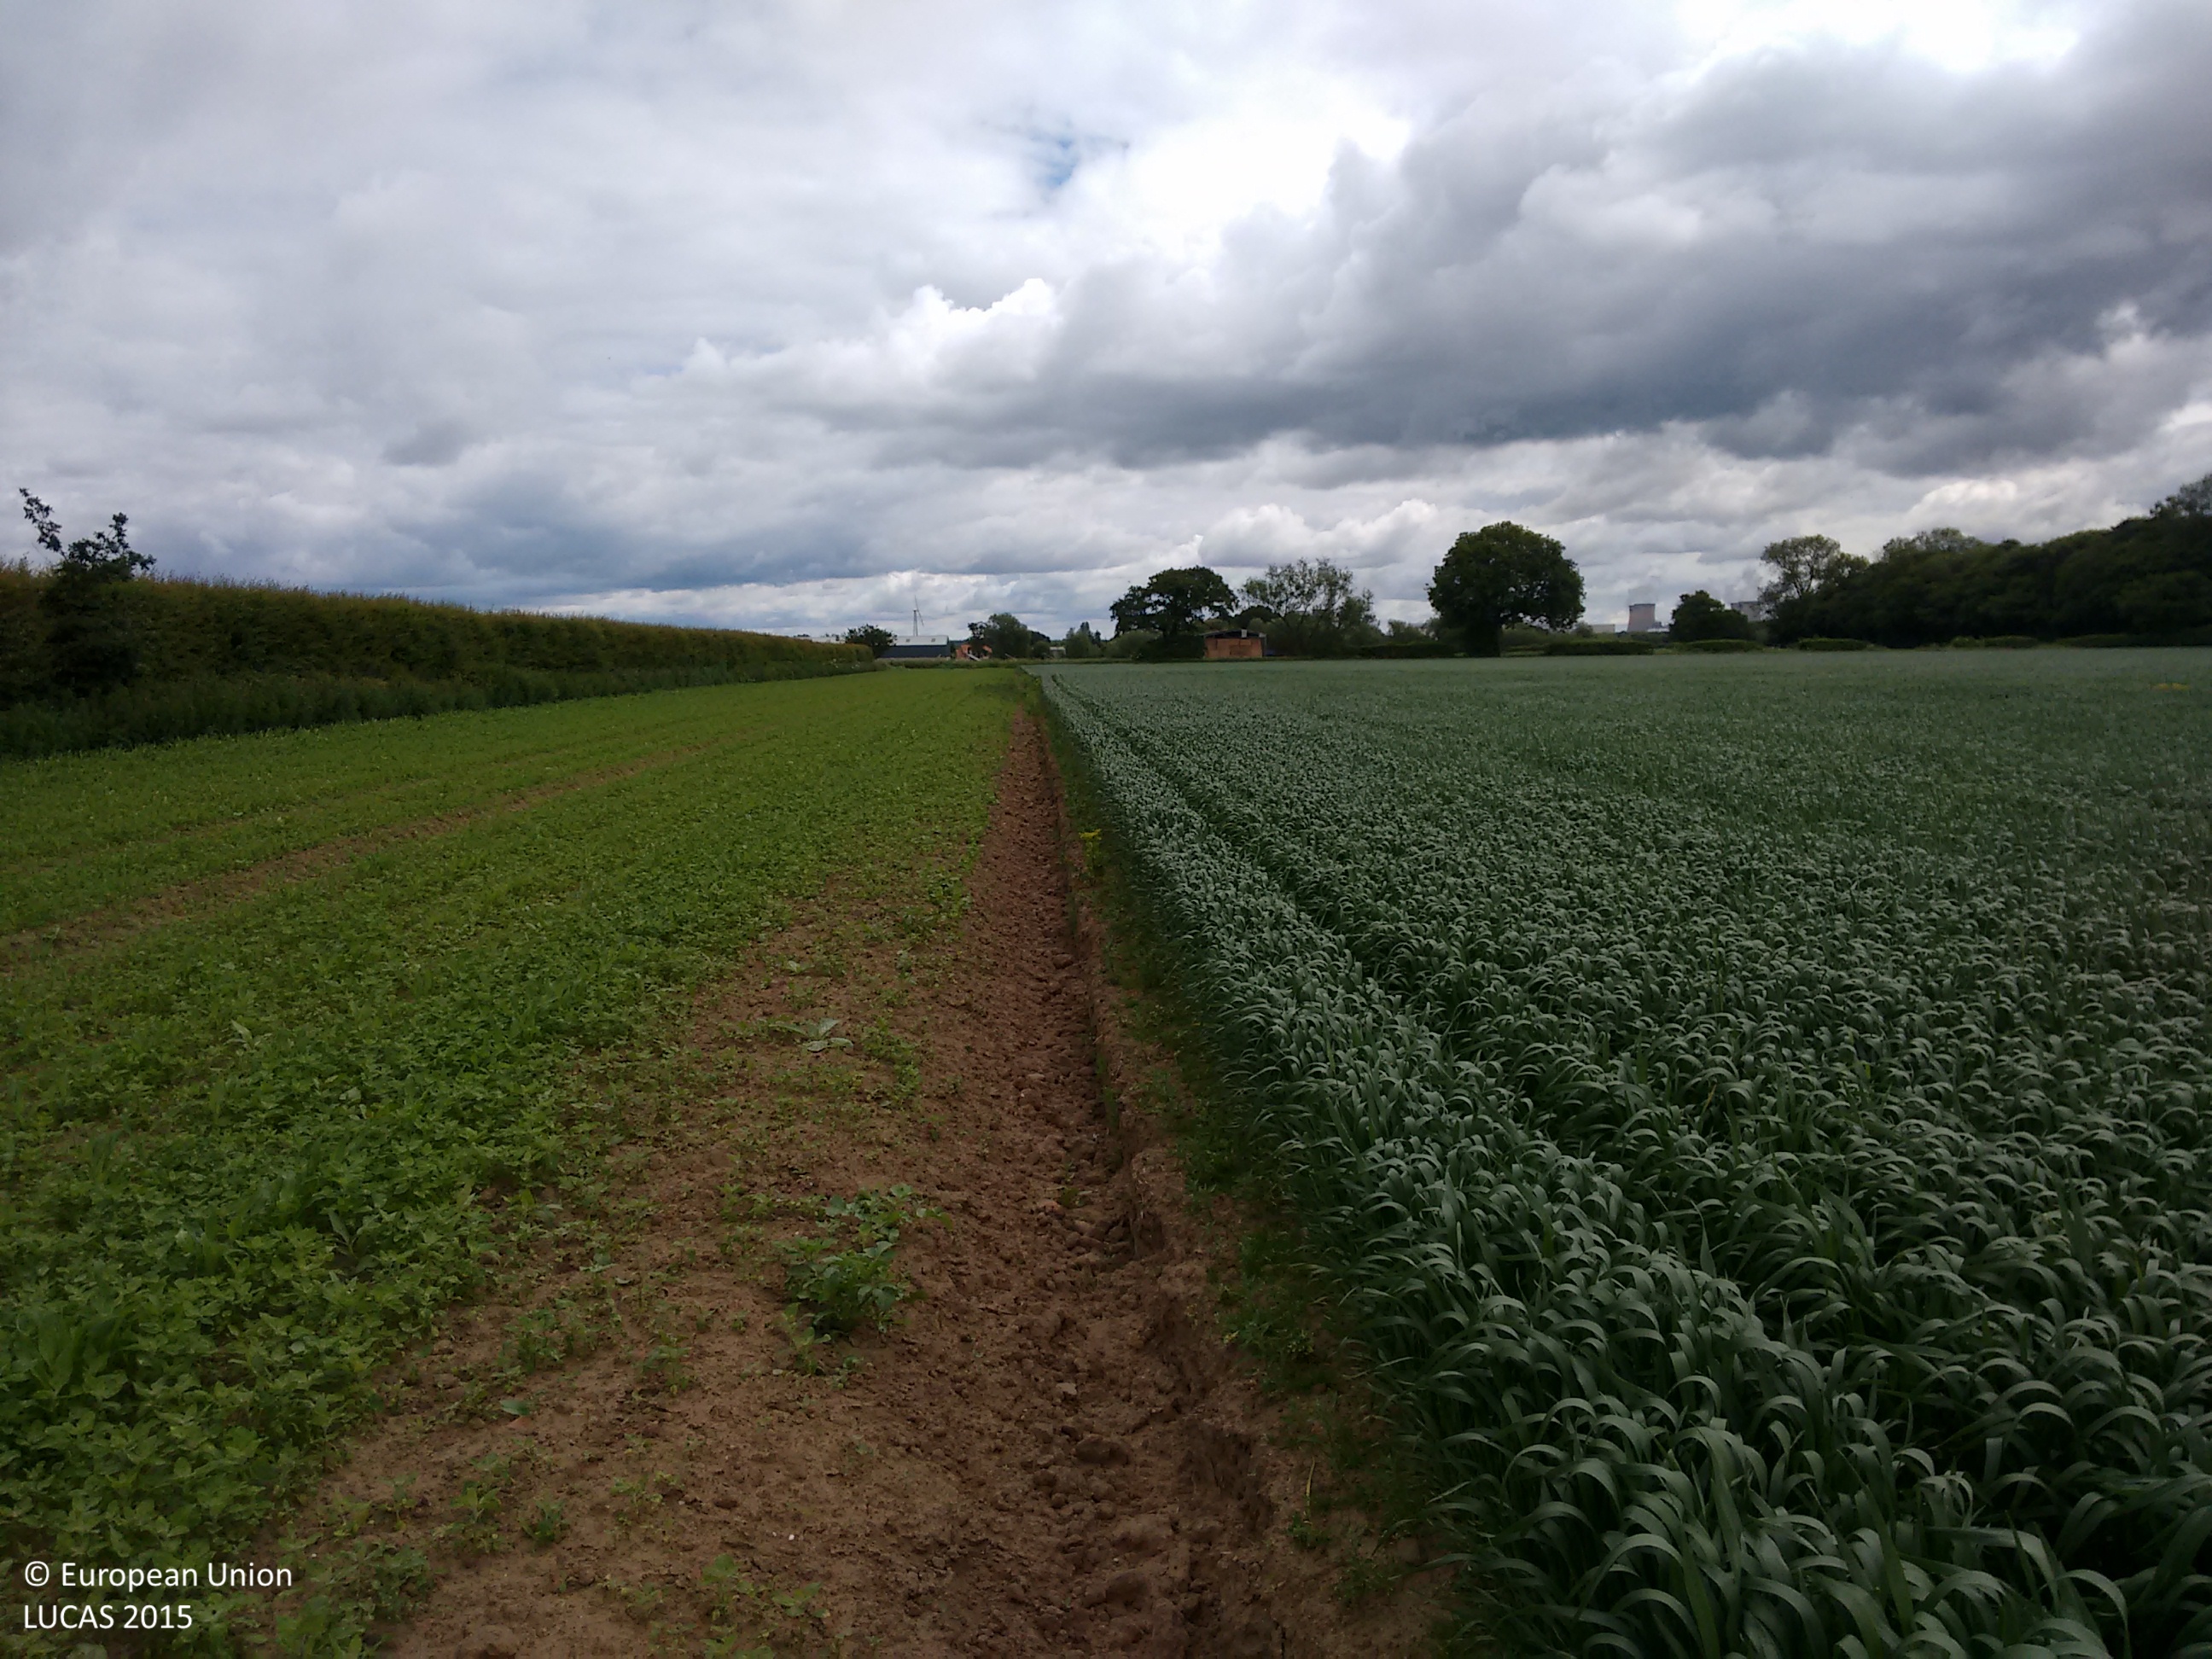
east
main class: Cropland
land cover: Common wheat
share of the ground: > 75 %
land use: Agriculture (excluding fallow land and kitchen gardens)
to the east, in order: Common wheat; Grass margins; Managed hedges; Grass margins; Sugar beet
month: June
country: GB
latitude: 53.7461
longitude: -1.0678
